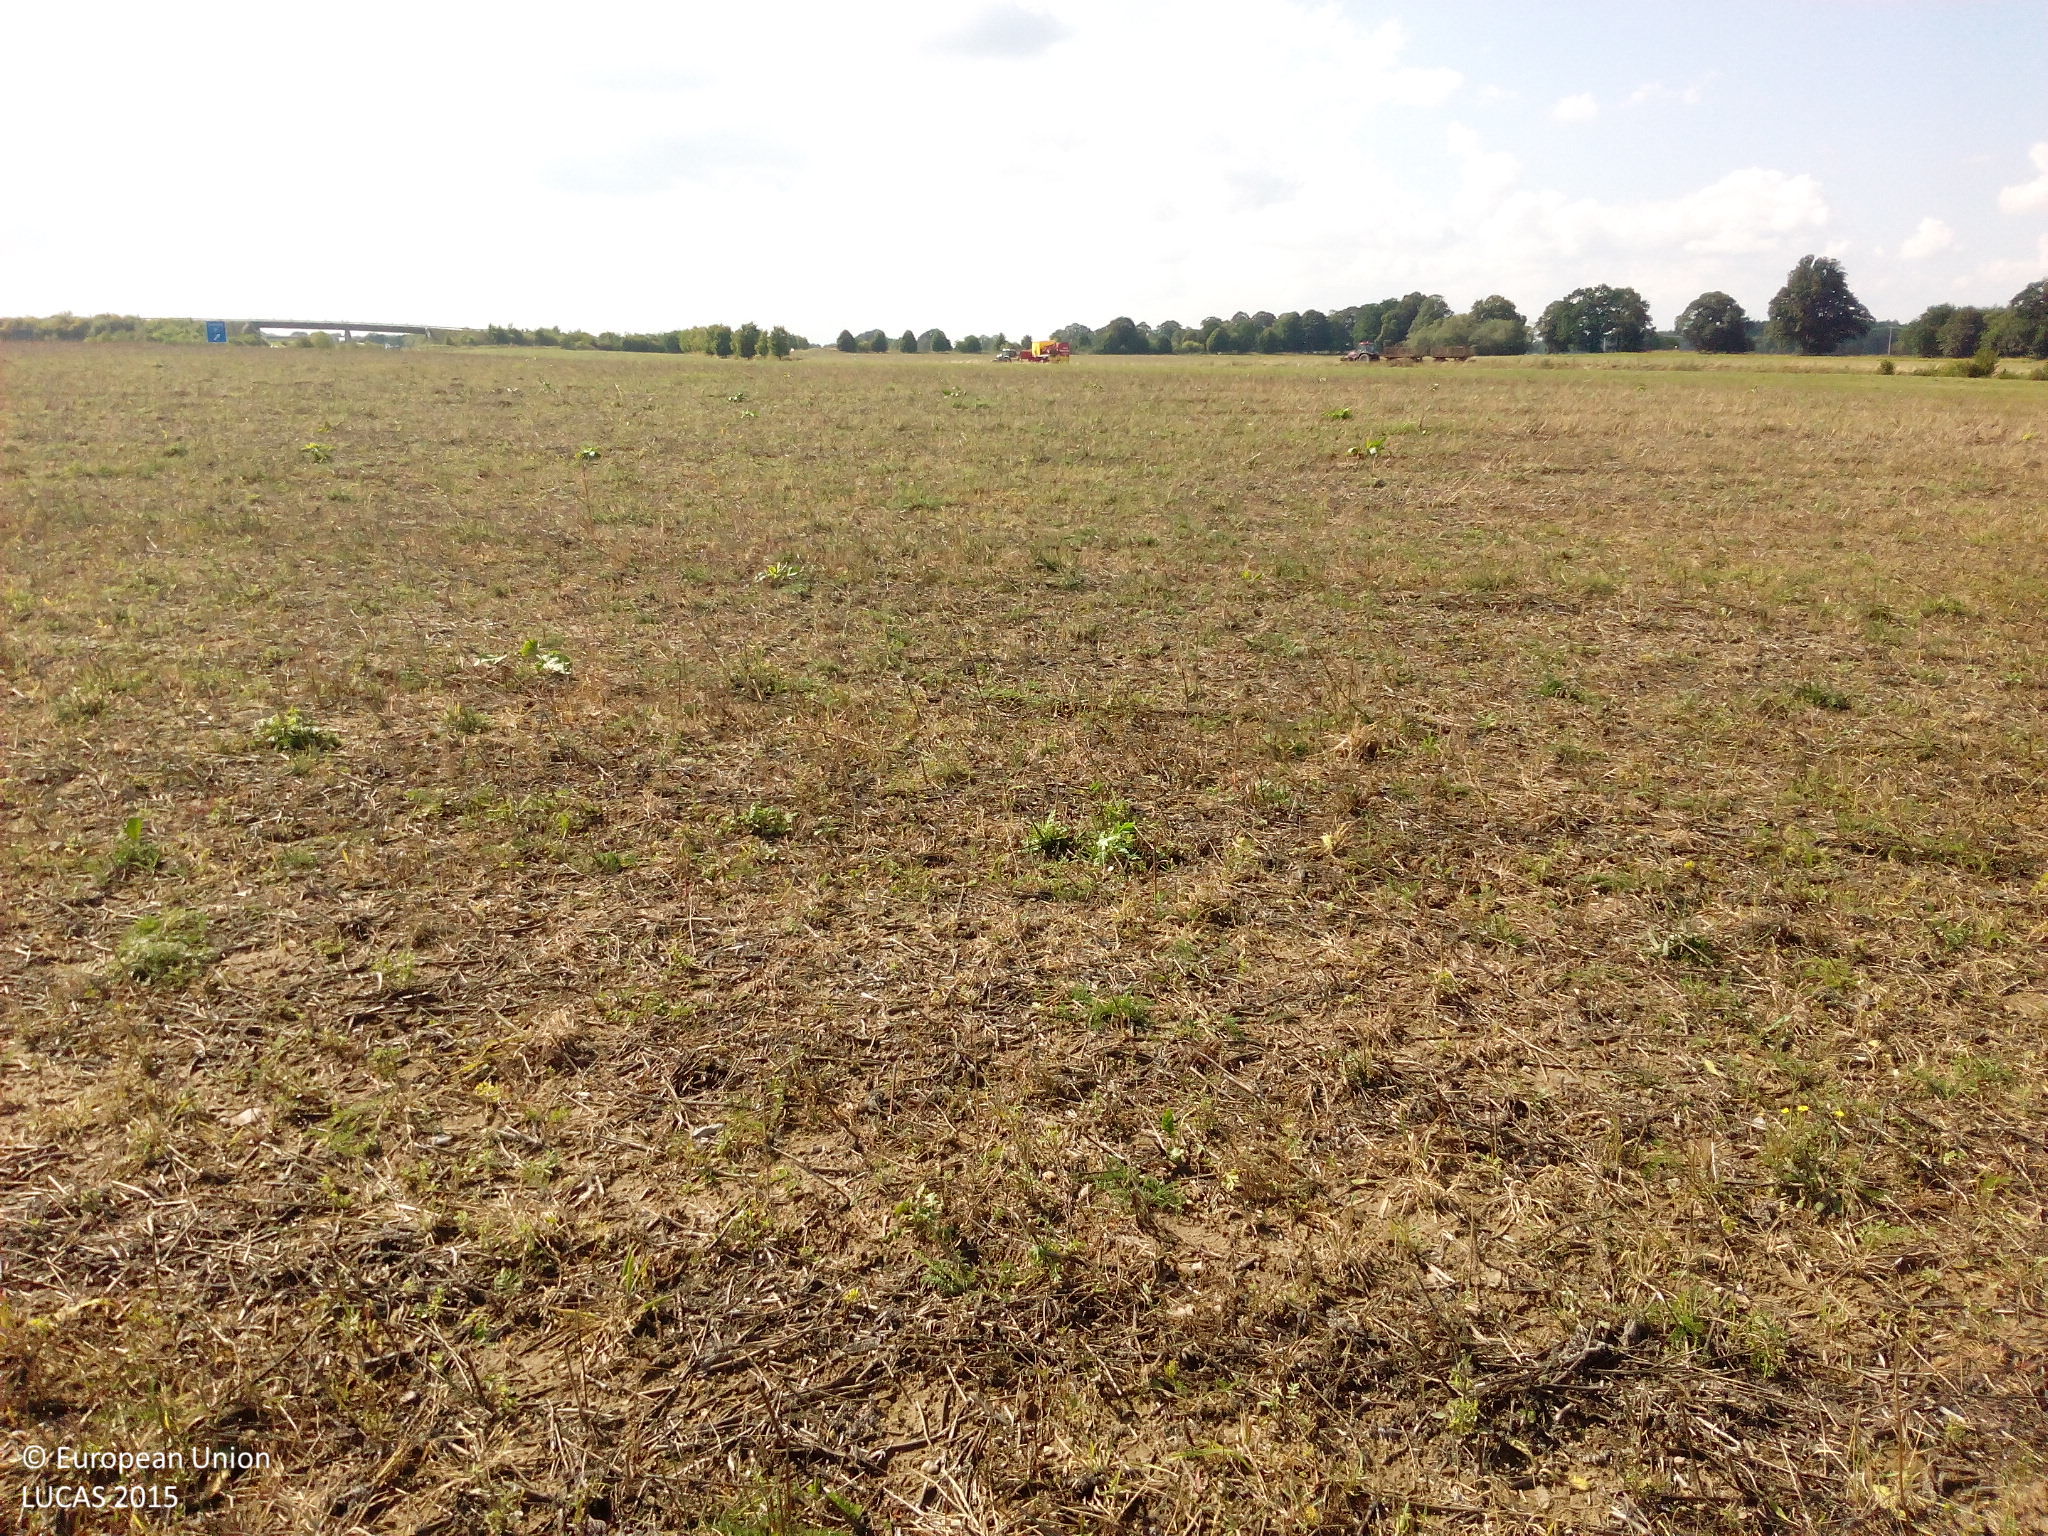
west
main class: Grassland
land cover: Spontaneously vegetated surfaces
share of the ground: 10 - 25 %
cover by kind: unconsolidated bare surface 60 %, herbaceous plants 40 %
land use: Agriculture (excluding fallow land and kitchen gardens)
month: August
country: DE
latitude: 54.0565
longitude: 12.6419
